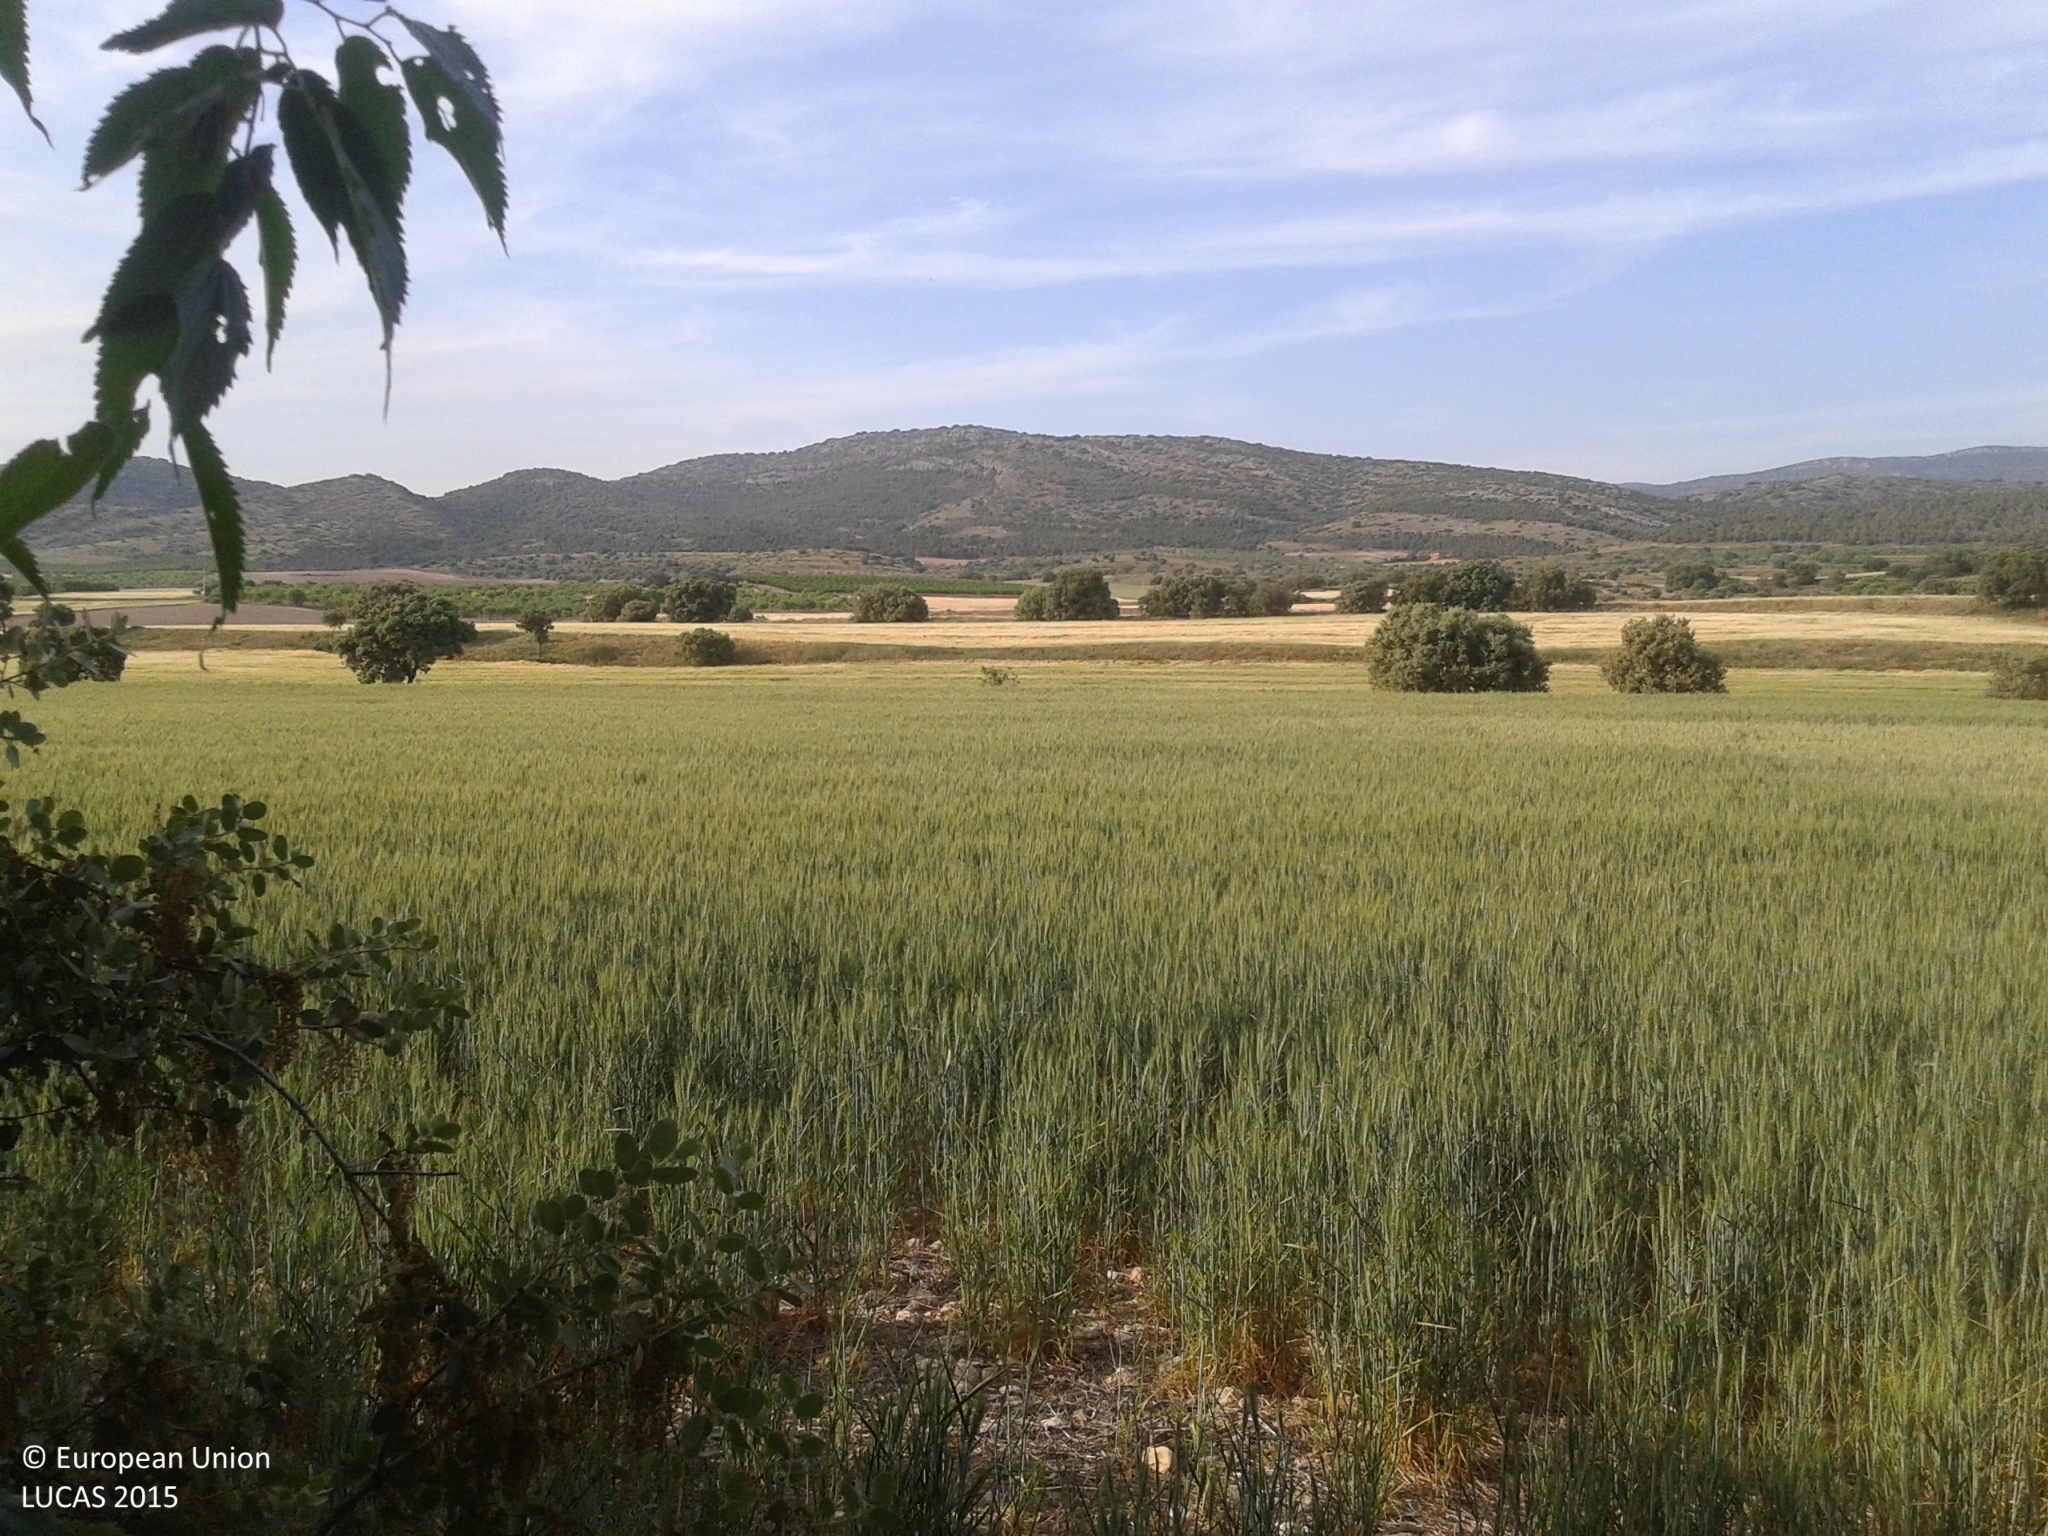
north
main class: Woodland
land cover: Broadleaved woodland
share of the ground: > 75 %
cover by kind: broadleaved forest trees 90 %, shrubs 5 %, herbaceous plants 5 %
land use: Semi-natural and natural areas not in use
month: May
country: ES
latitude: 41.8371
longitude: 0.6292
